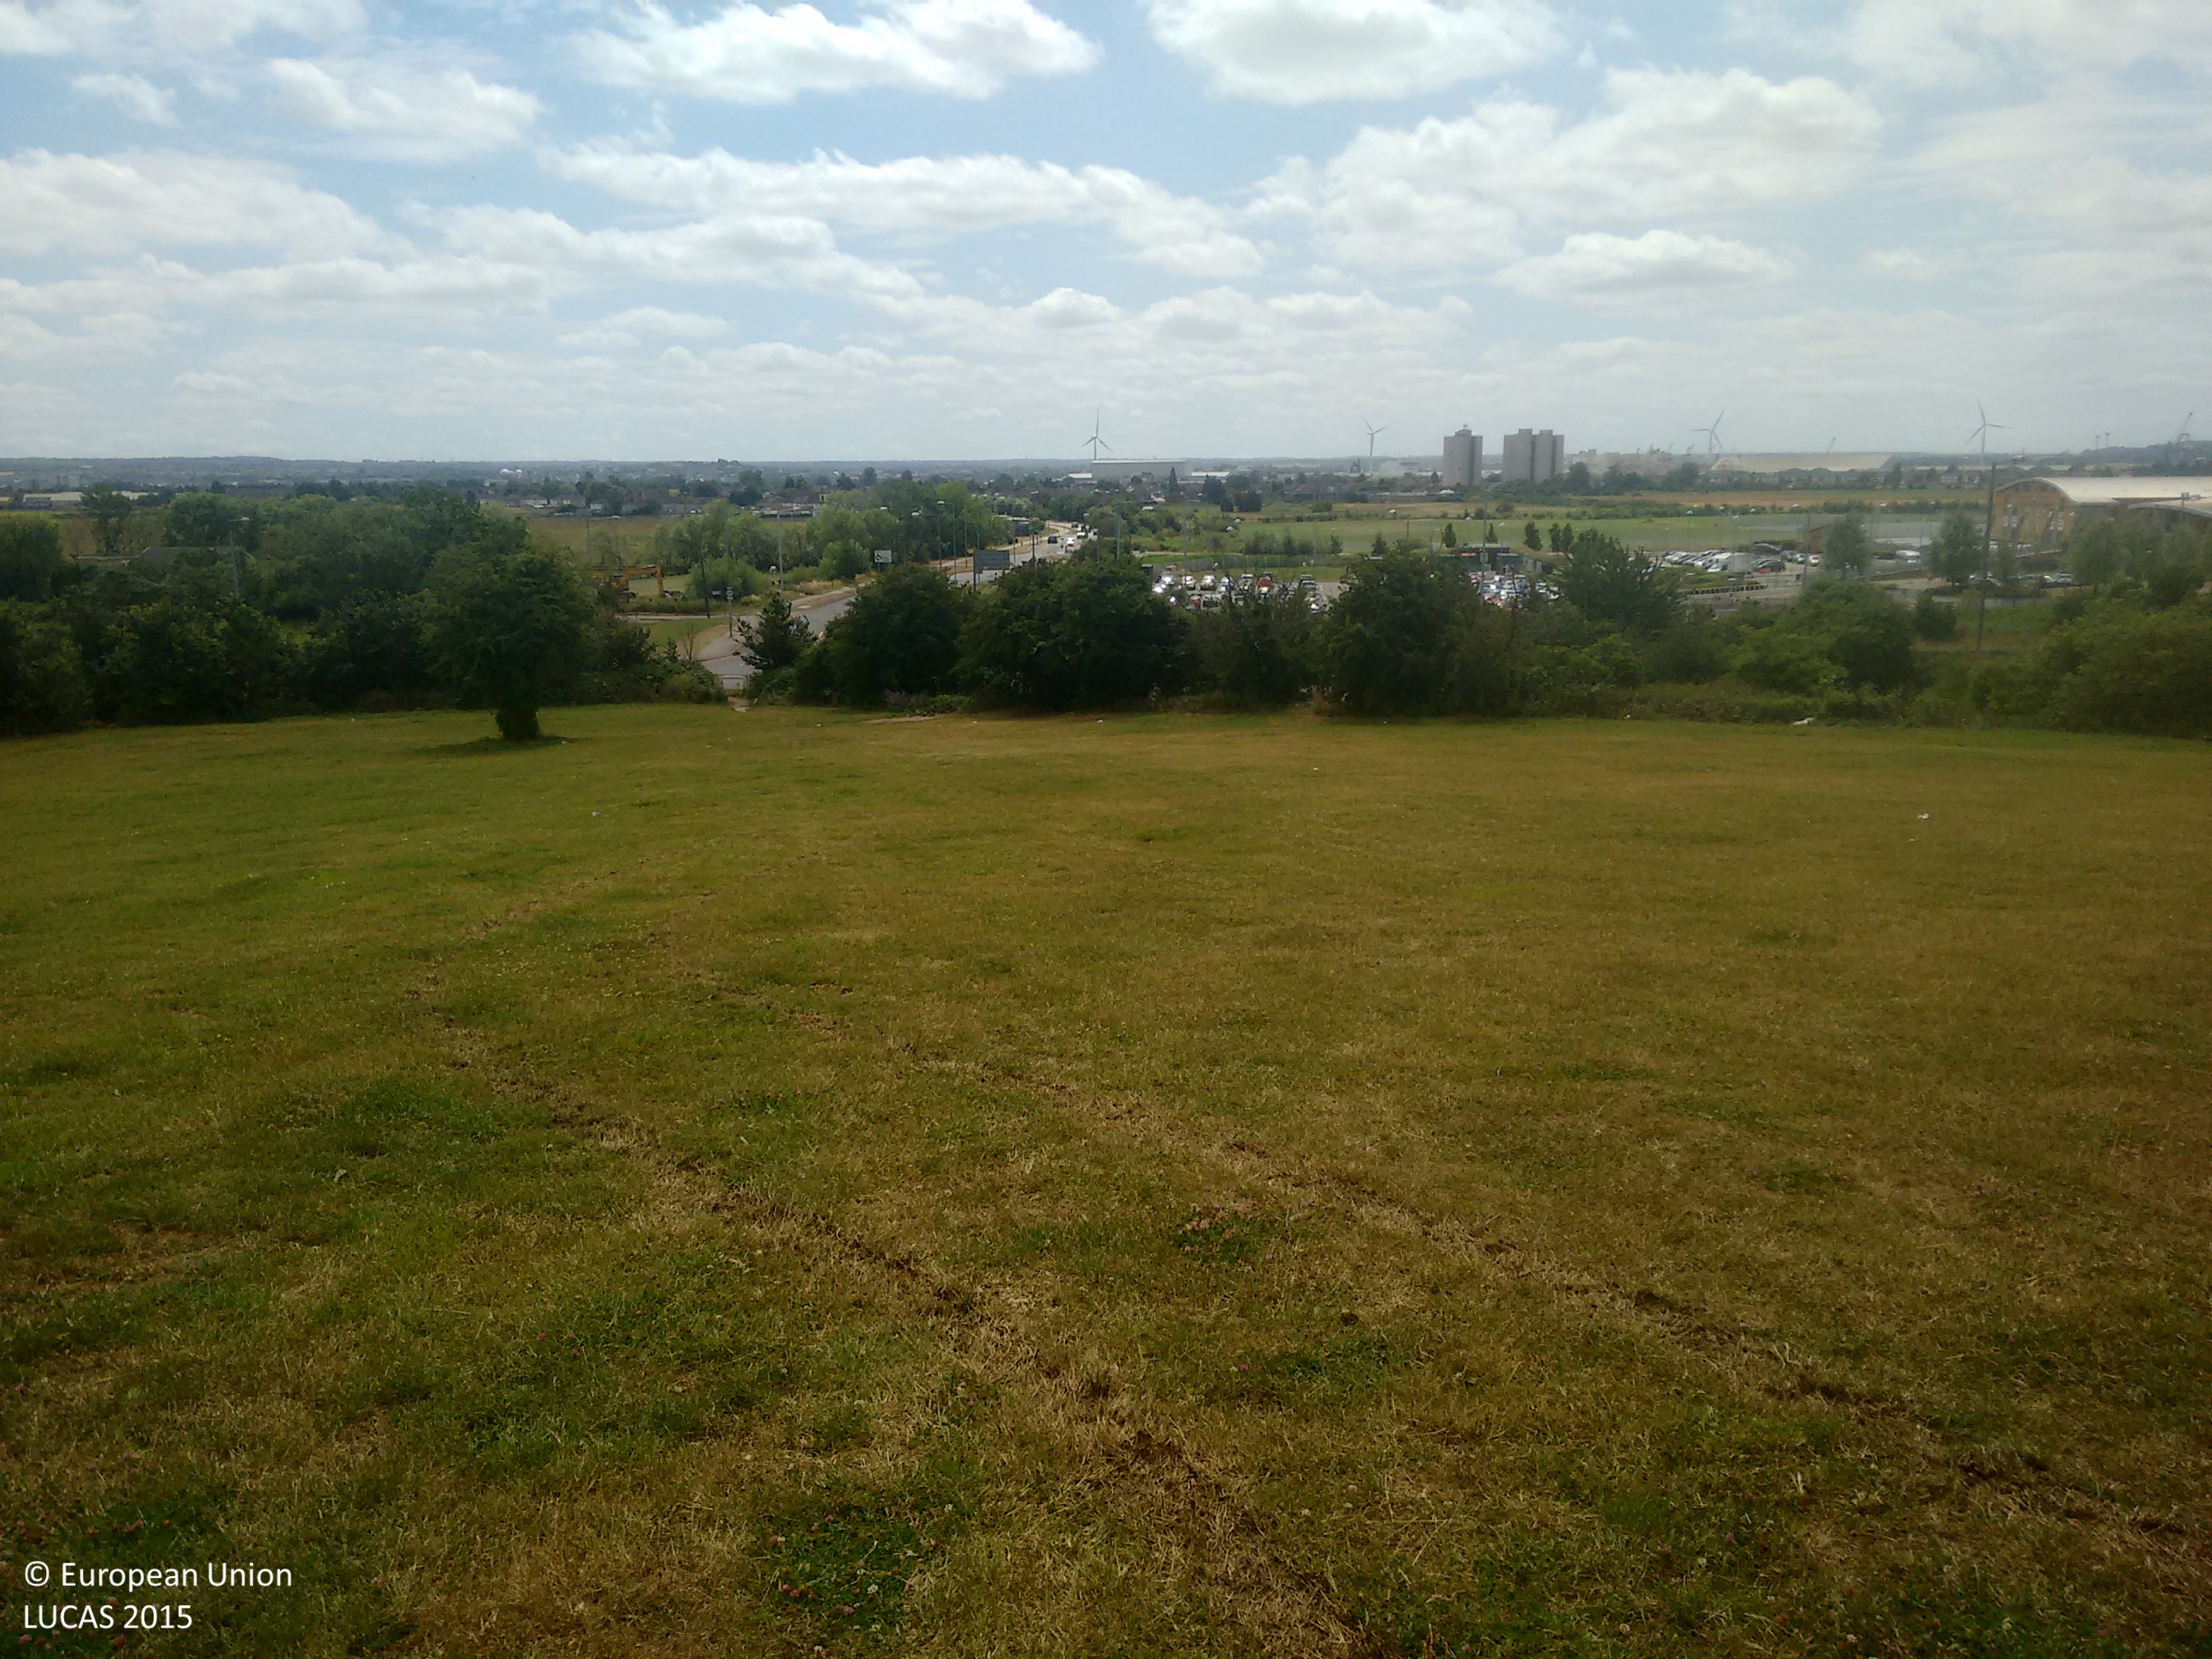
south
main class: Grassland
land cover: Grassland without tree/shrub cover
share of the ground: > 75 %
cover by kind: herbaceous plants 100 %
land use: Community services
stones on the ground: < 10 %
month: July
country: GB
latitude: 51.4778
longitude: 0.3671
